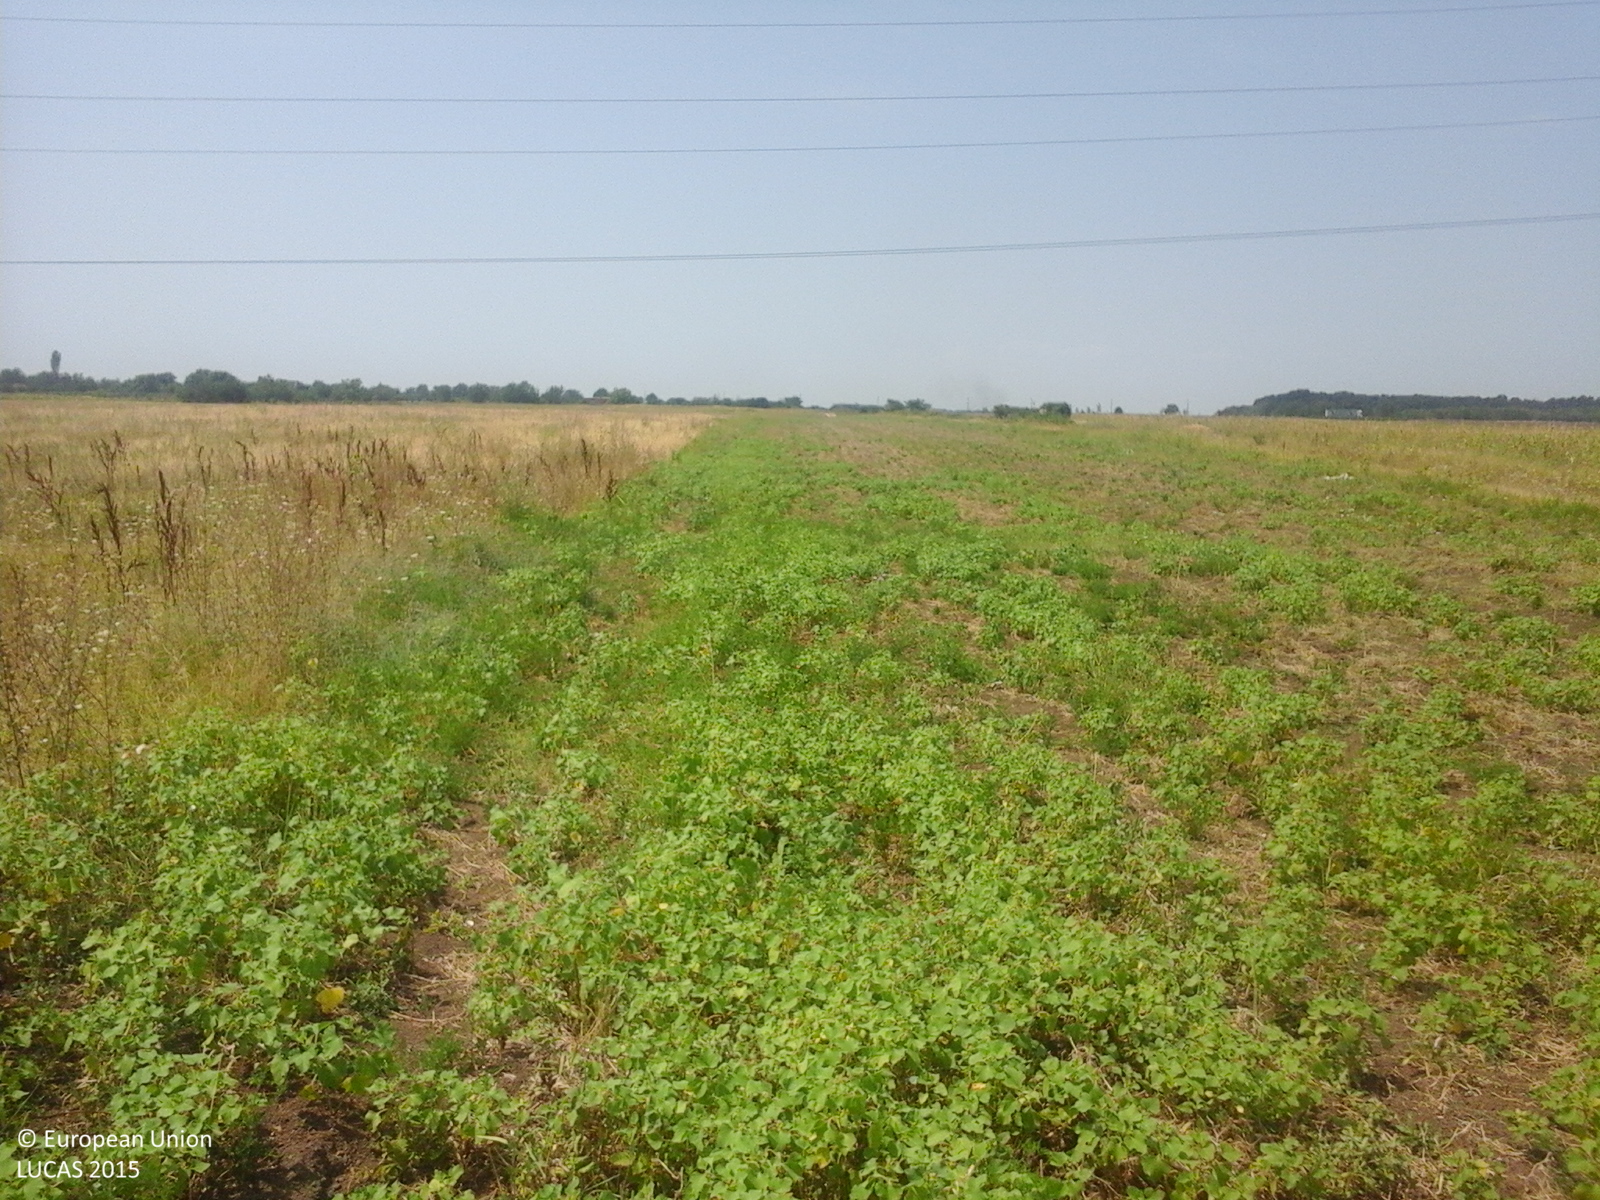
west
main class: Grassland
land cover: Spontaneously vegetated surfaces
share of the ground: > 75 %
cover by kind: herbaceous plants 100 %
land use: Fallow land
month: August
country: RO
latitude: 44.2672
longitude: 22.9332
